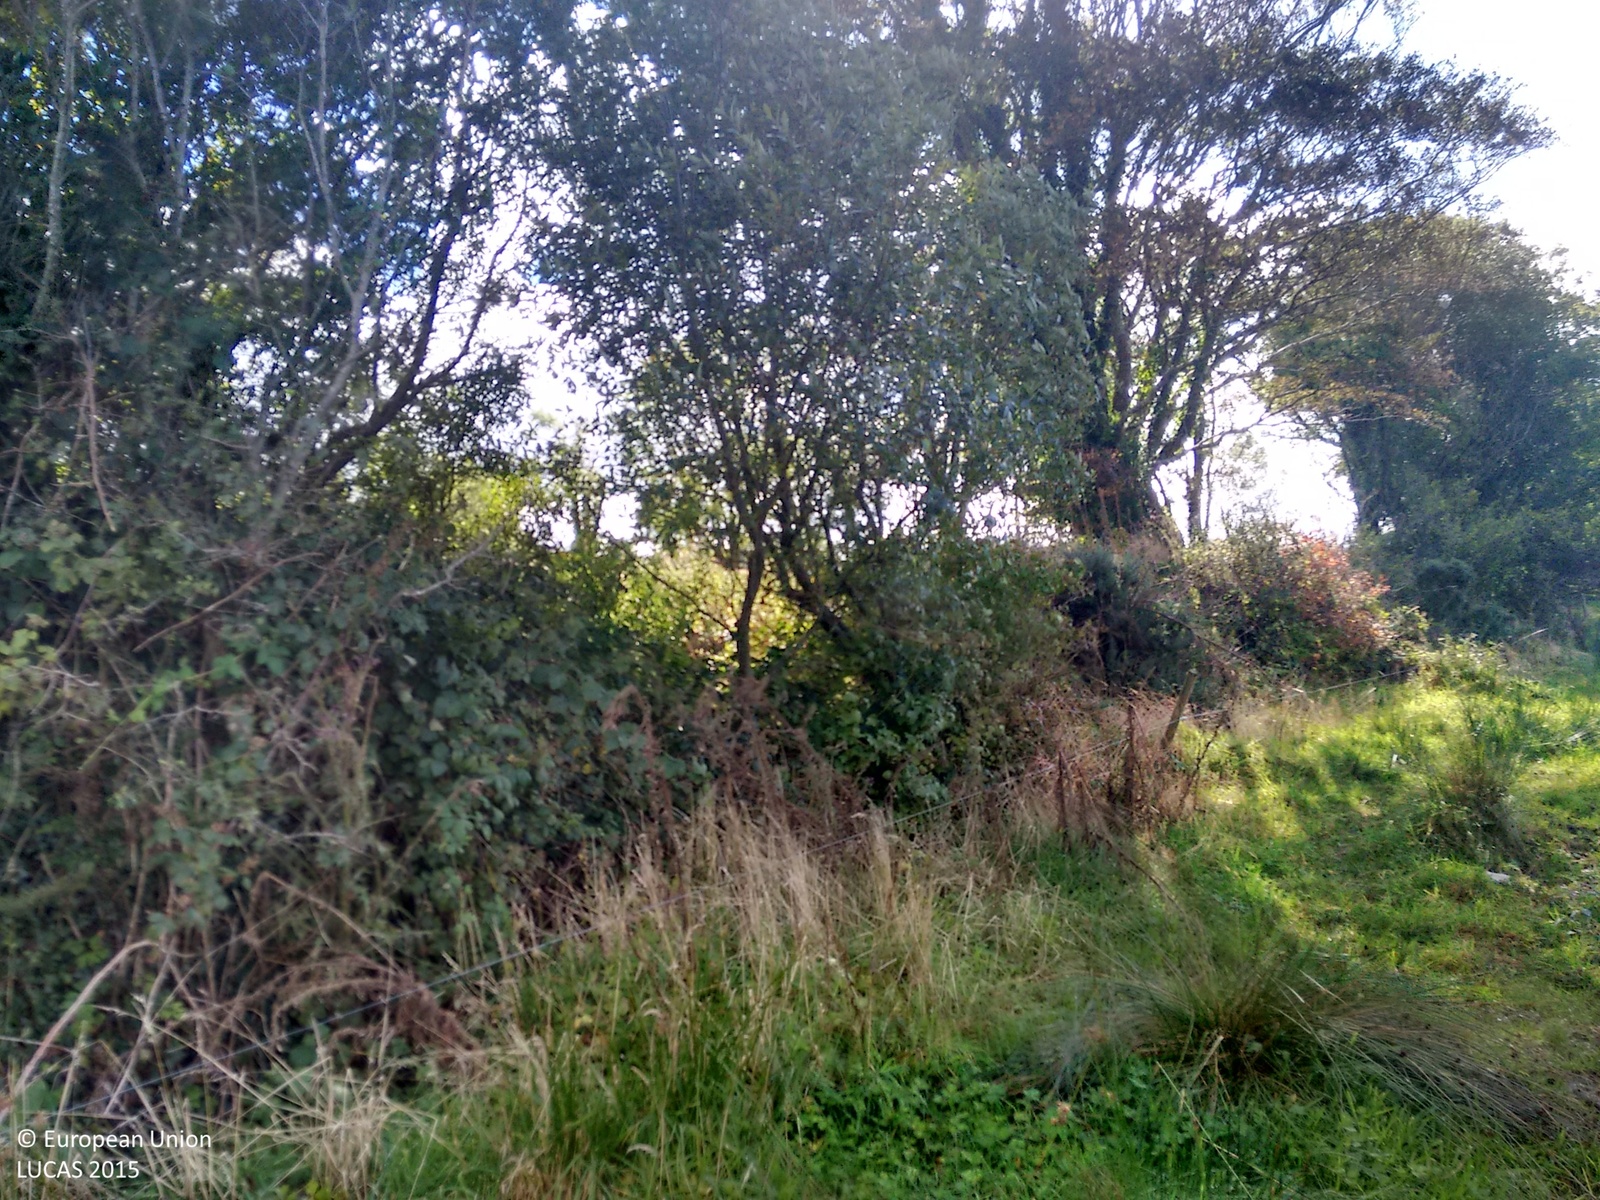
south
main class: Grassland
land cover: Grassland without tree/shrub cover
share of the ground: > 75 %
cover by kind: herbaceous plants 95 %, shrubs 5 %
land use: Agriculture (excluding fallow land and kitchen gardens)
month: September
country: IE
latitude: 52.4823
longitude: -9.4776
